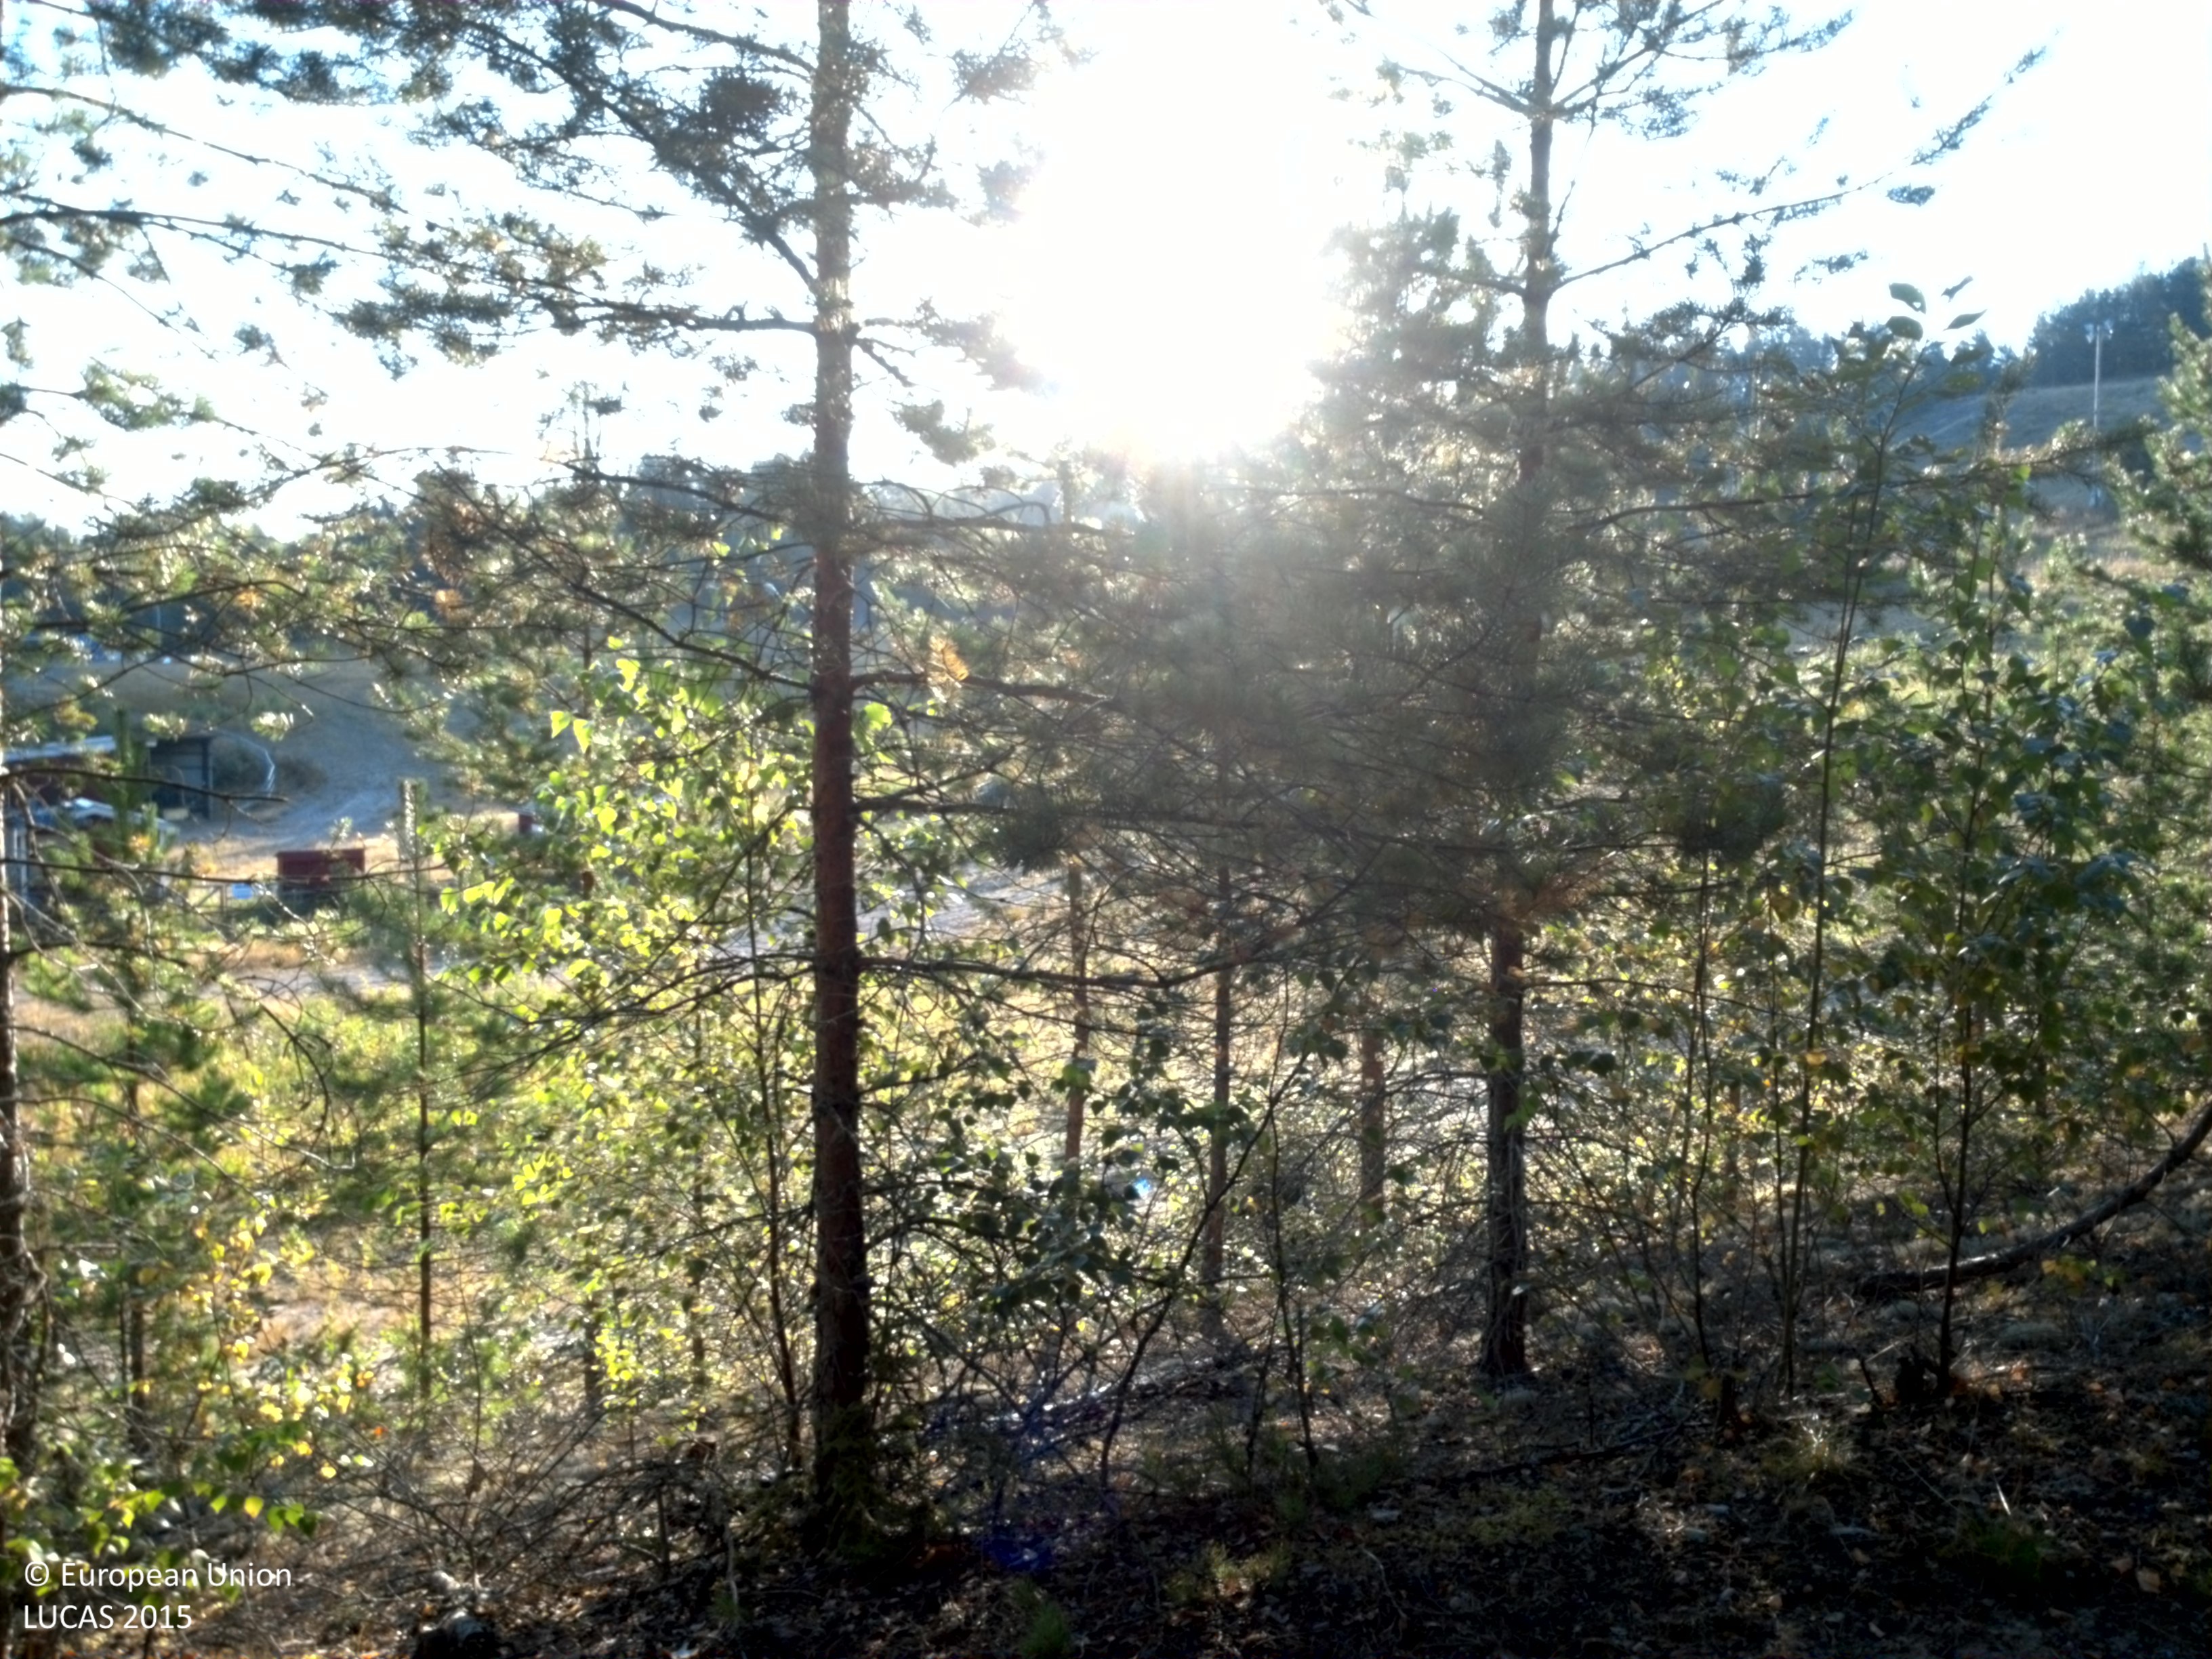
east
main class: Woodland
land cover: Pine dominated mixed woodland
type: boreal forest
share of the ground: 25 - 50 %
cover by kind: coniferous forest trees 35 %, lichens and mosses 25 %, consolidated bare surface 20 %, broadleaved forest trees 15 %, herbaceous plants 5 %
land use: Sport
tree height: > 5 m
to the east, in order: Pine dominated mixed woodland; Tracks; Pine dominated mixed woodland; Shrubland with sparse tree cover; Sand; Artificial constructions in urban areas; Shrubland without tree cover; Sand; Pine dominated coniferous woodland; Tracks; Pine dominated coniferous woodland
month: August
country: SE
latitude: 59.5288
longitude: 13.3335
